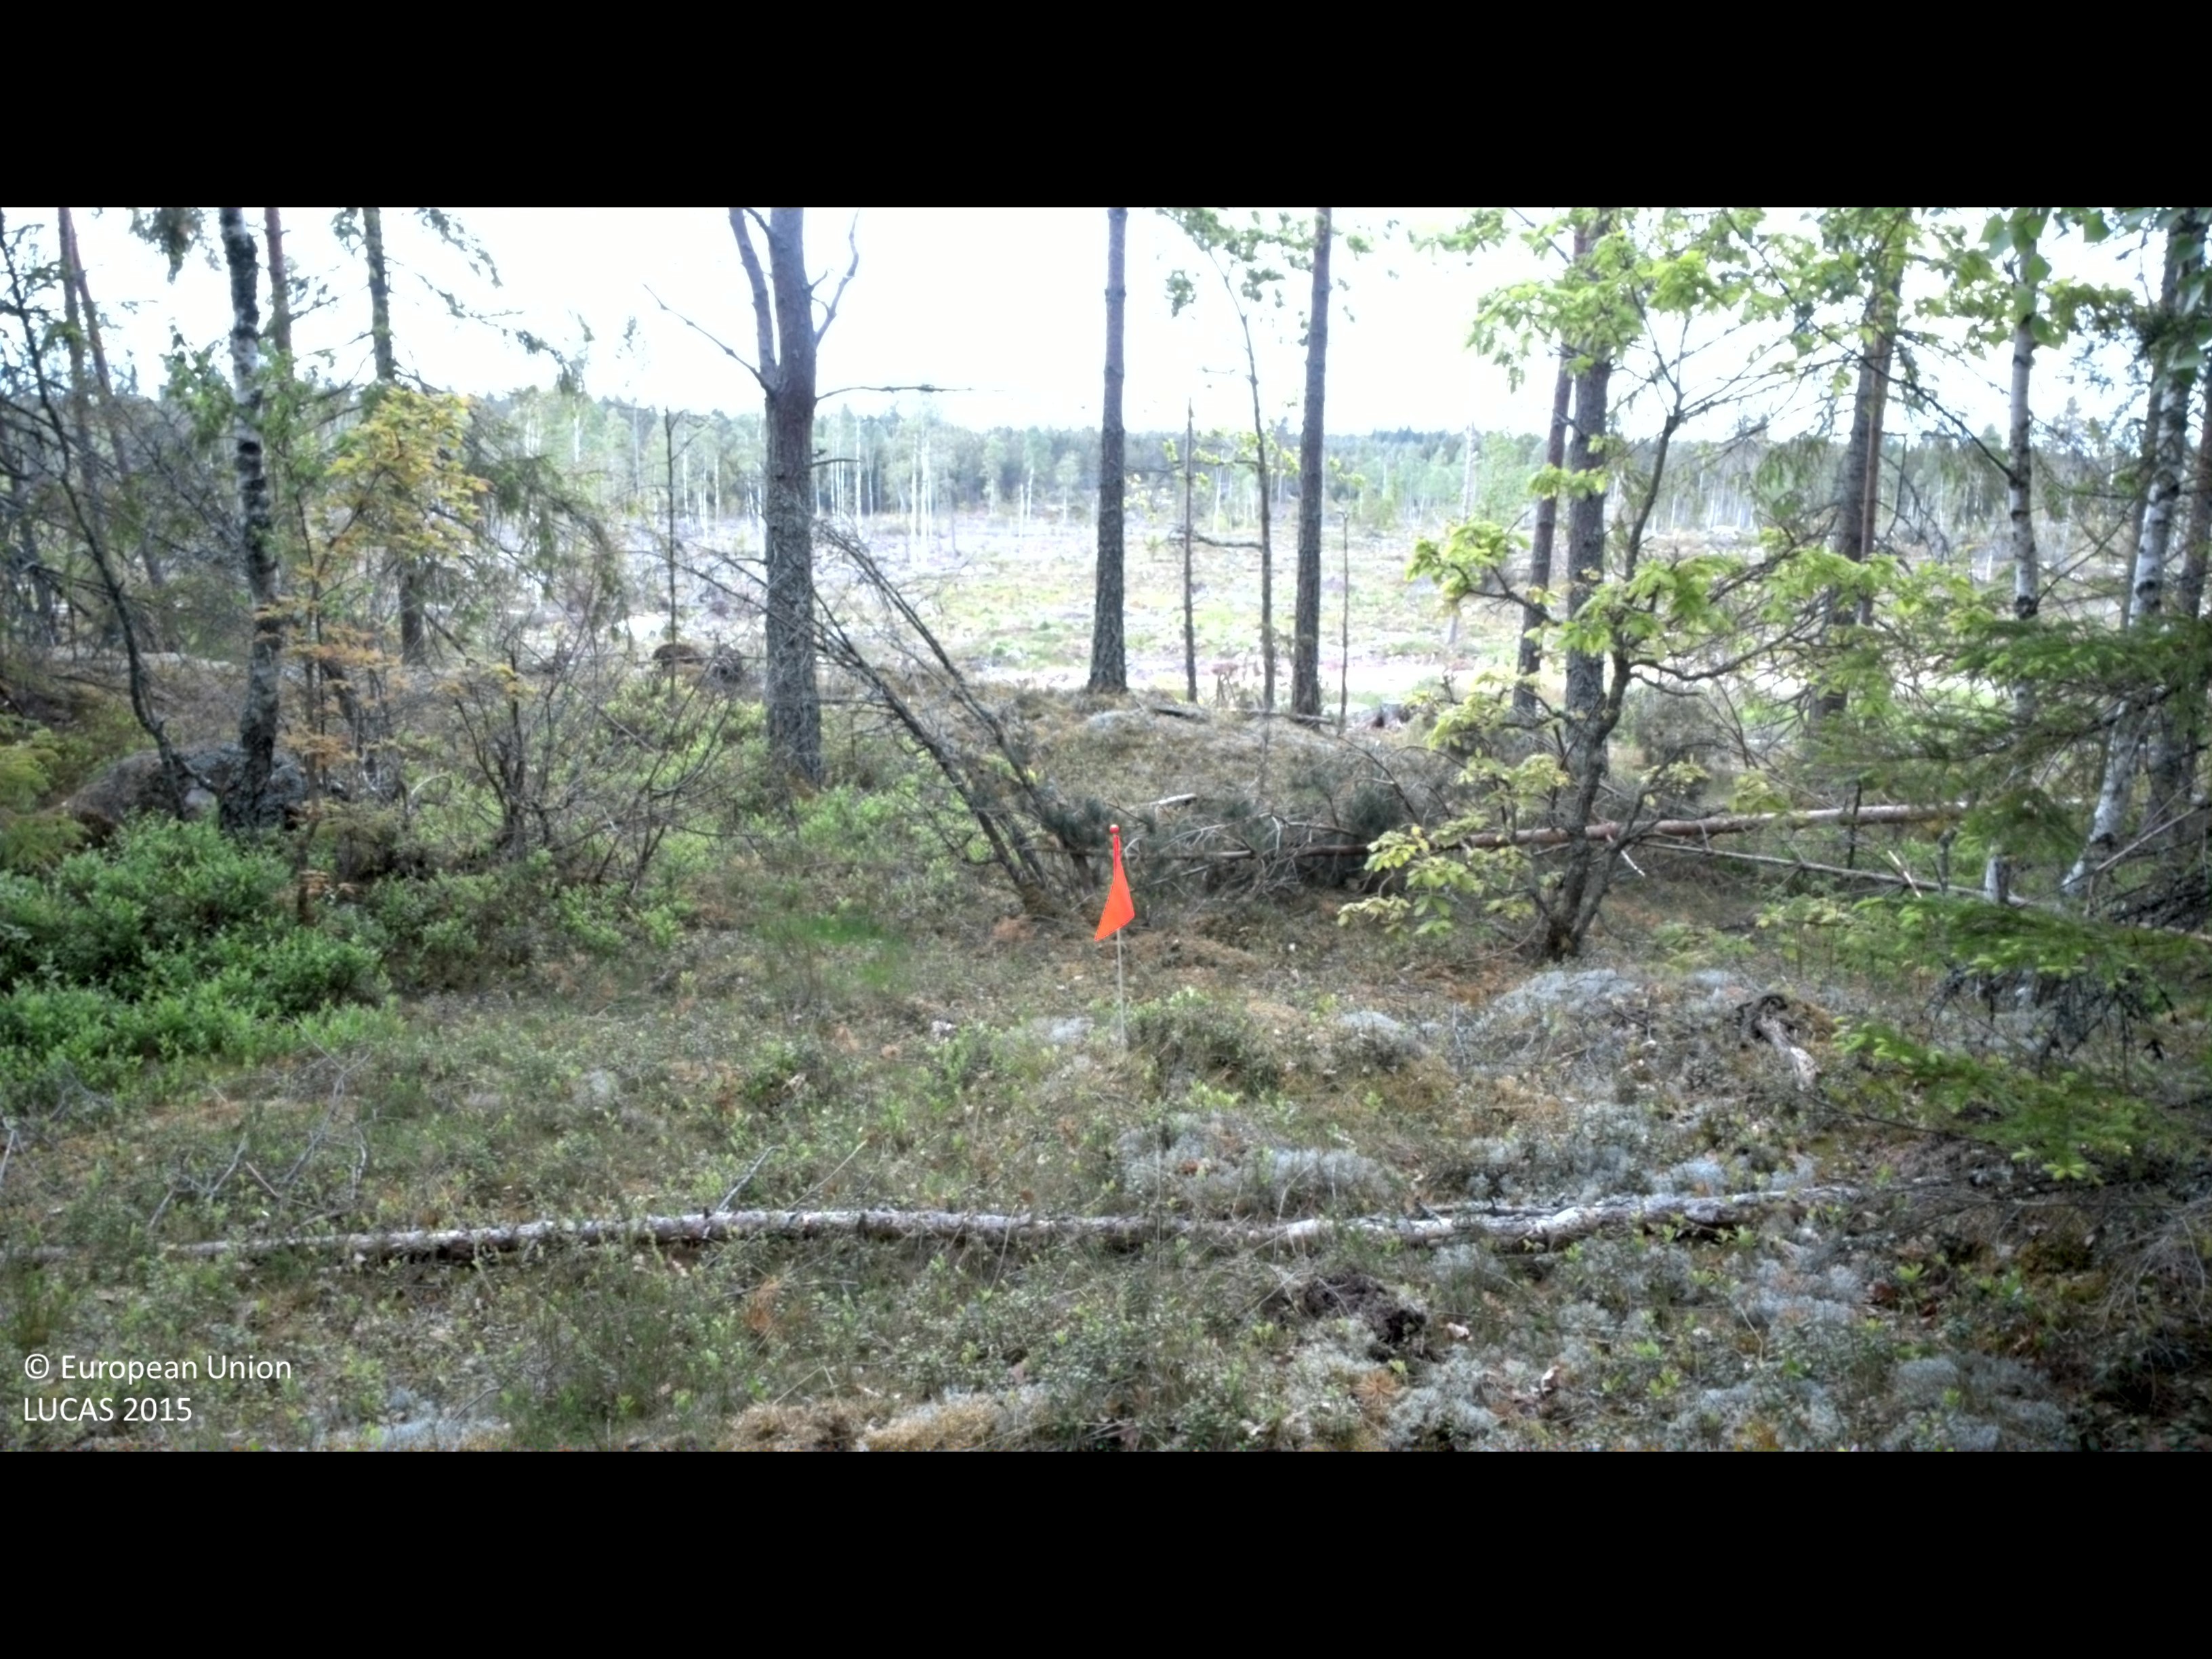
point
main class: Woodland
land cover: Pine dominated coniferous woodland
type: boreal forest
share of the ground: 50 - 75 %
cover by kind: coniferous forest trees 50 %, shrubs 25 %, lichens and mosses 15 %, broadleaved forest trees 10 %
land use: Forestry
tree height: > 5 m
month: June
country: SE
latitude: 57.6607
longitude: 16.2162
